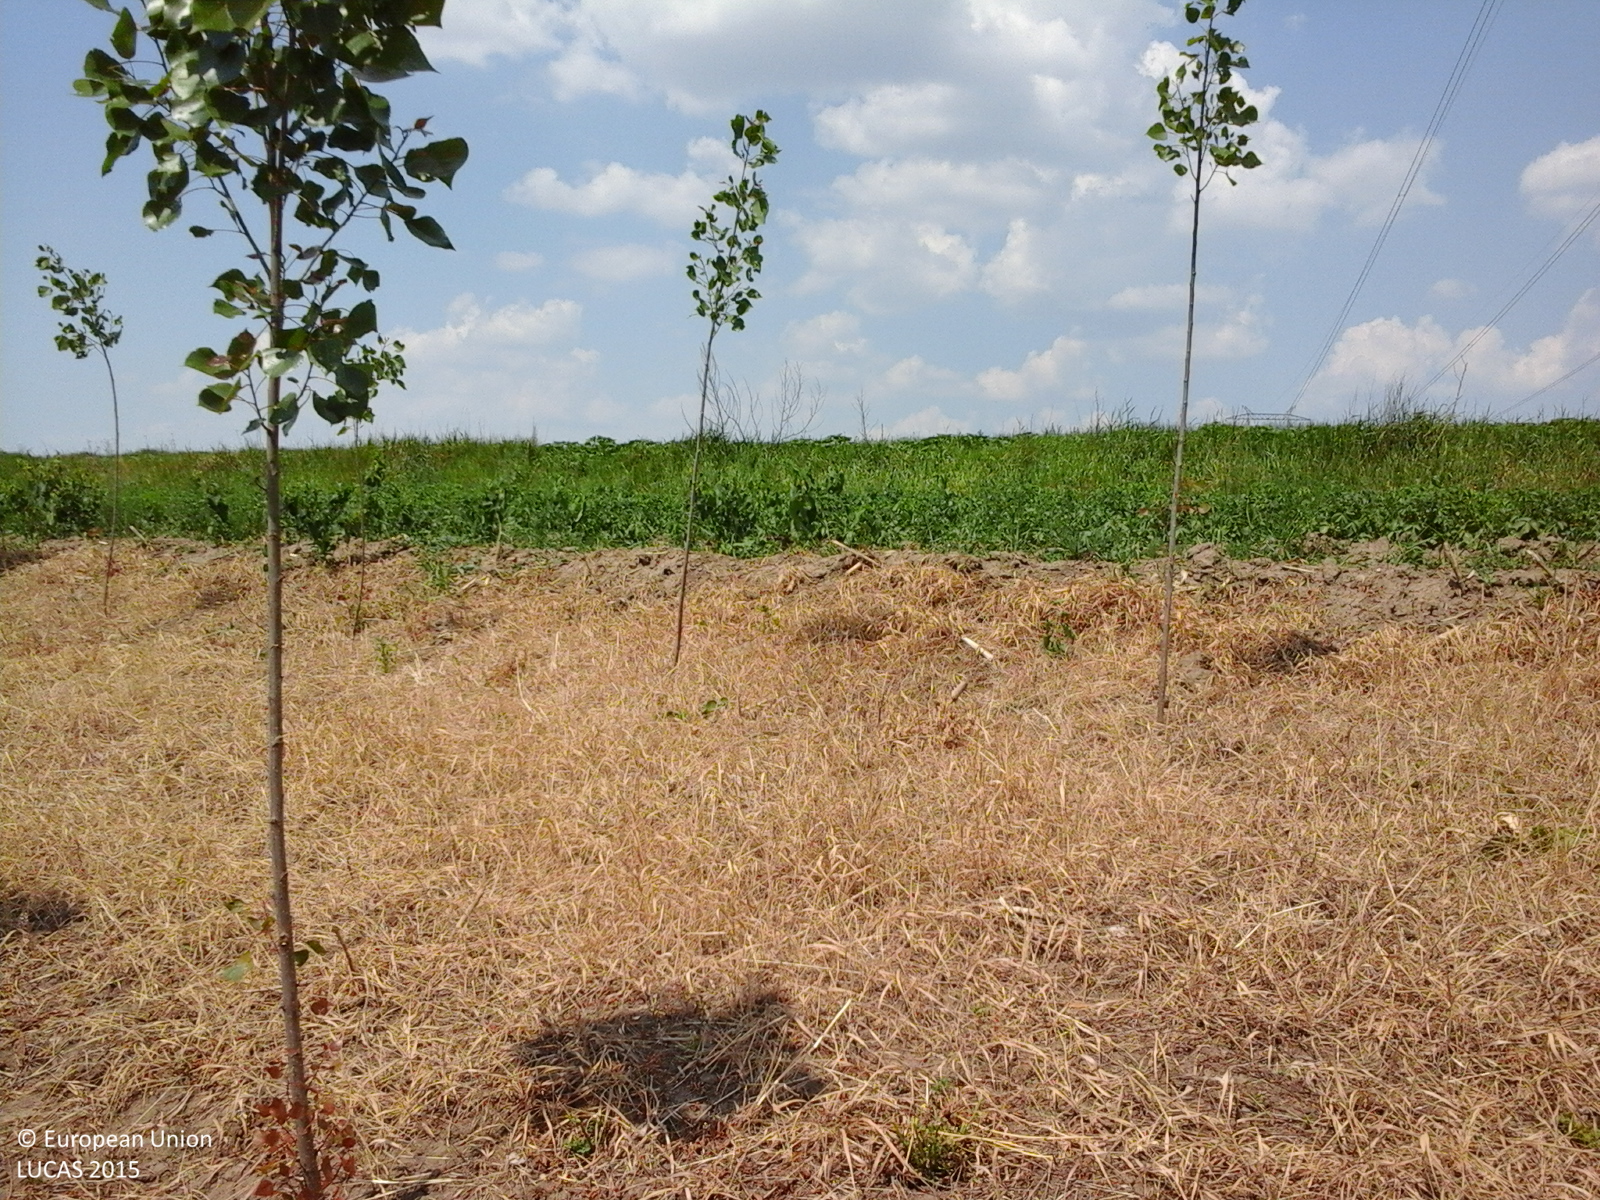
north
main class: Woodland
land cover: Broadleaved woodland
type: non-riverine alder, birch or aspen forest
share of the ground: 10 - 25 %
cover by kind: herbaceous plants 60 %, broadleaved forest trees 40 %
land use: Forestry
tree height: < 5 m
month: June
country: RO
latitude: 46.9162
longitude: 26.8359
